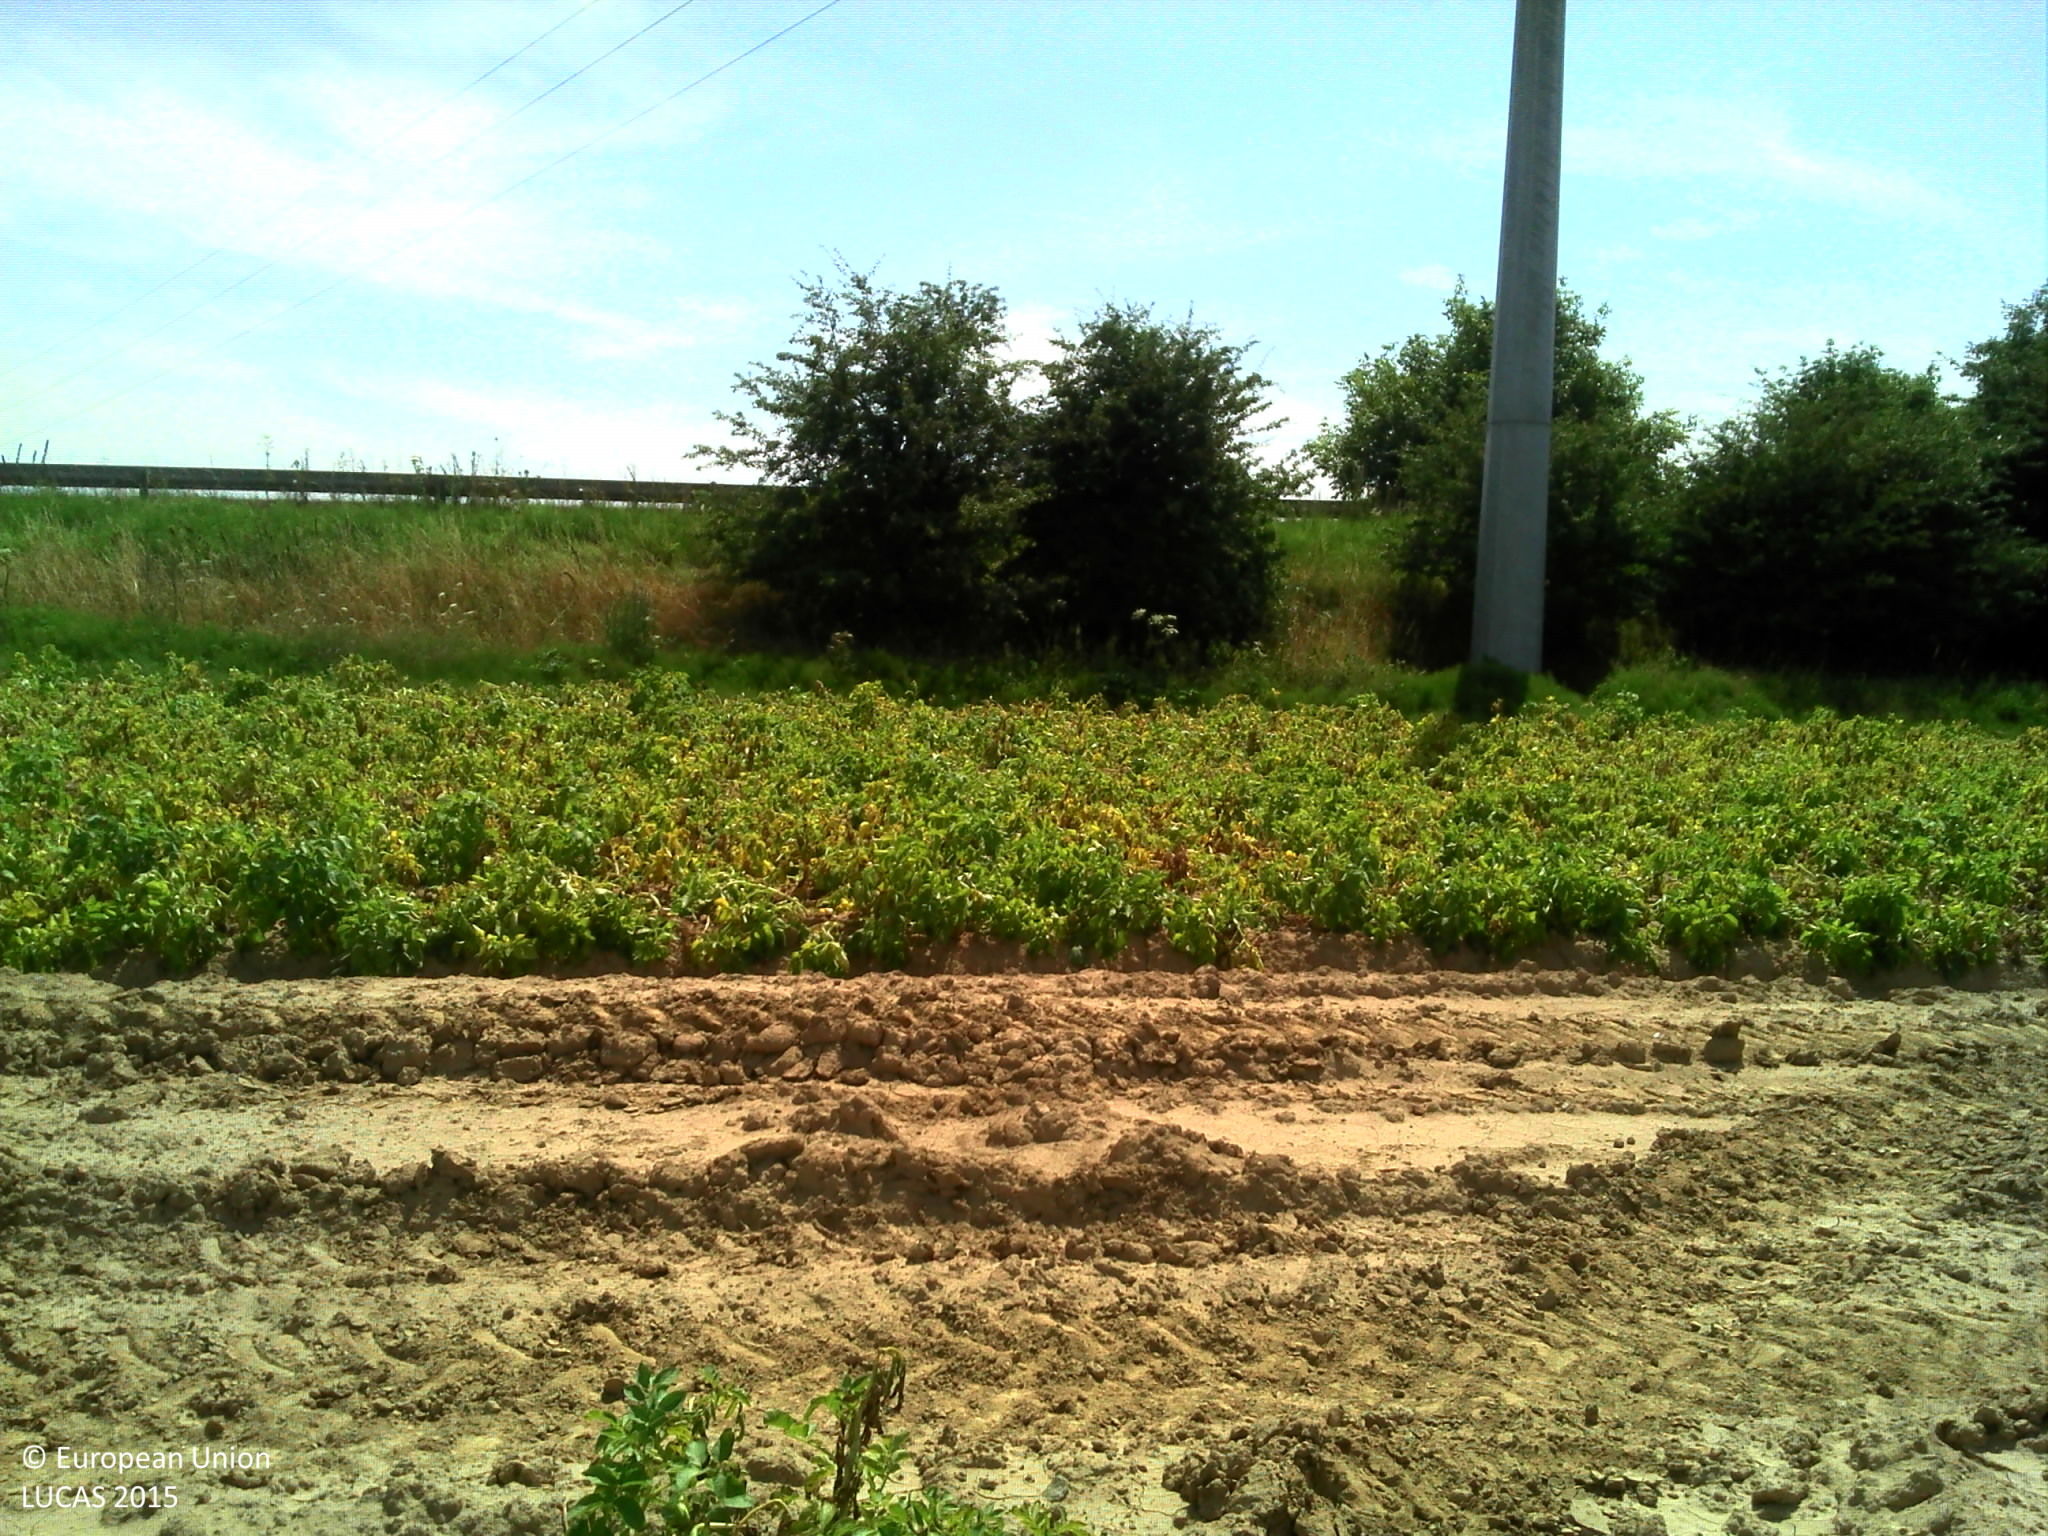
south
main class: Cropland
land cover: Potatoes
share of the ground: 25 - 50 %
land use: Agriculture (excluding fallow land and kitchen gardens)
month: August
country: FR
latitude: 49.7390
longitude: 2.7877
